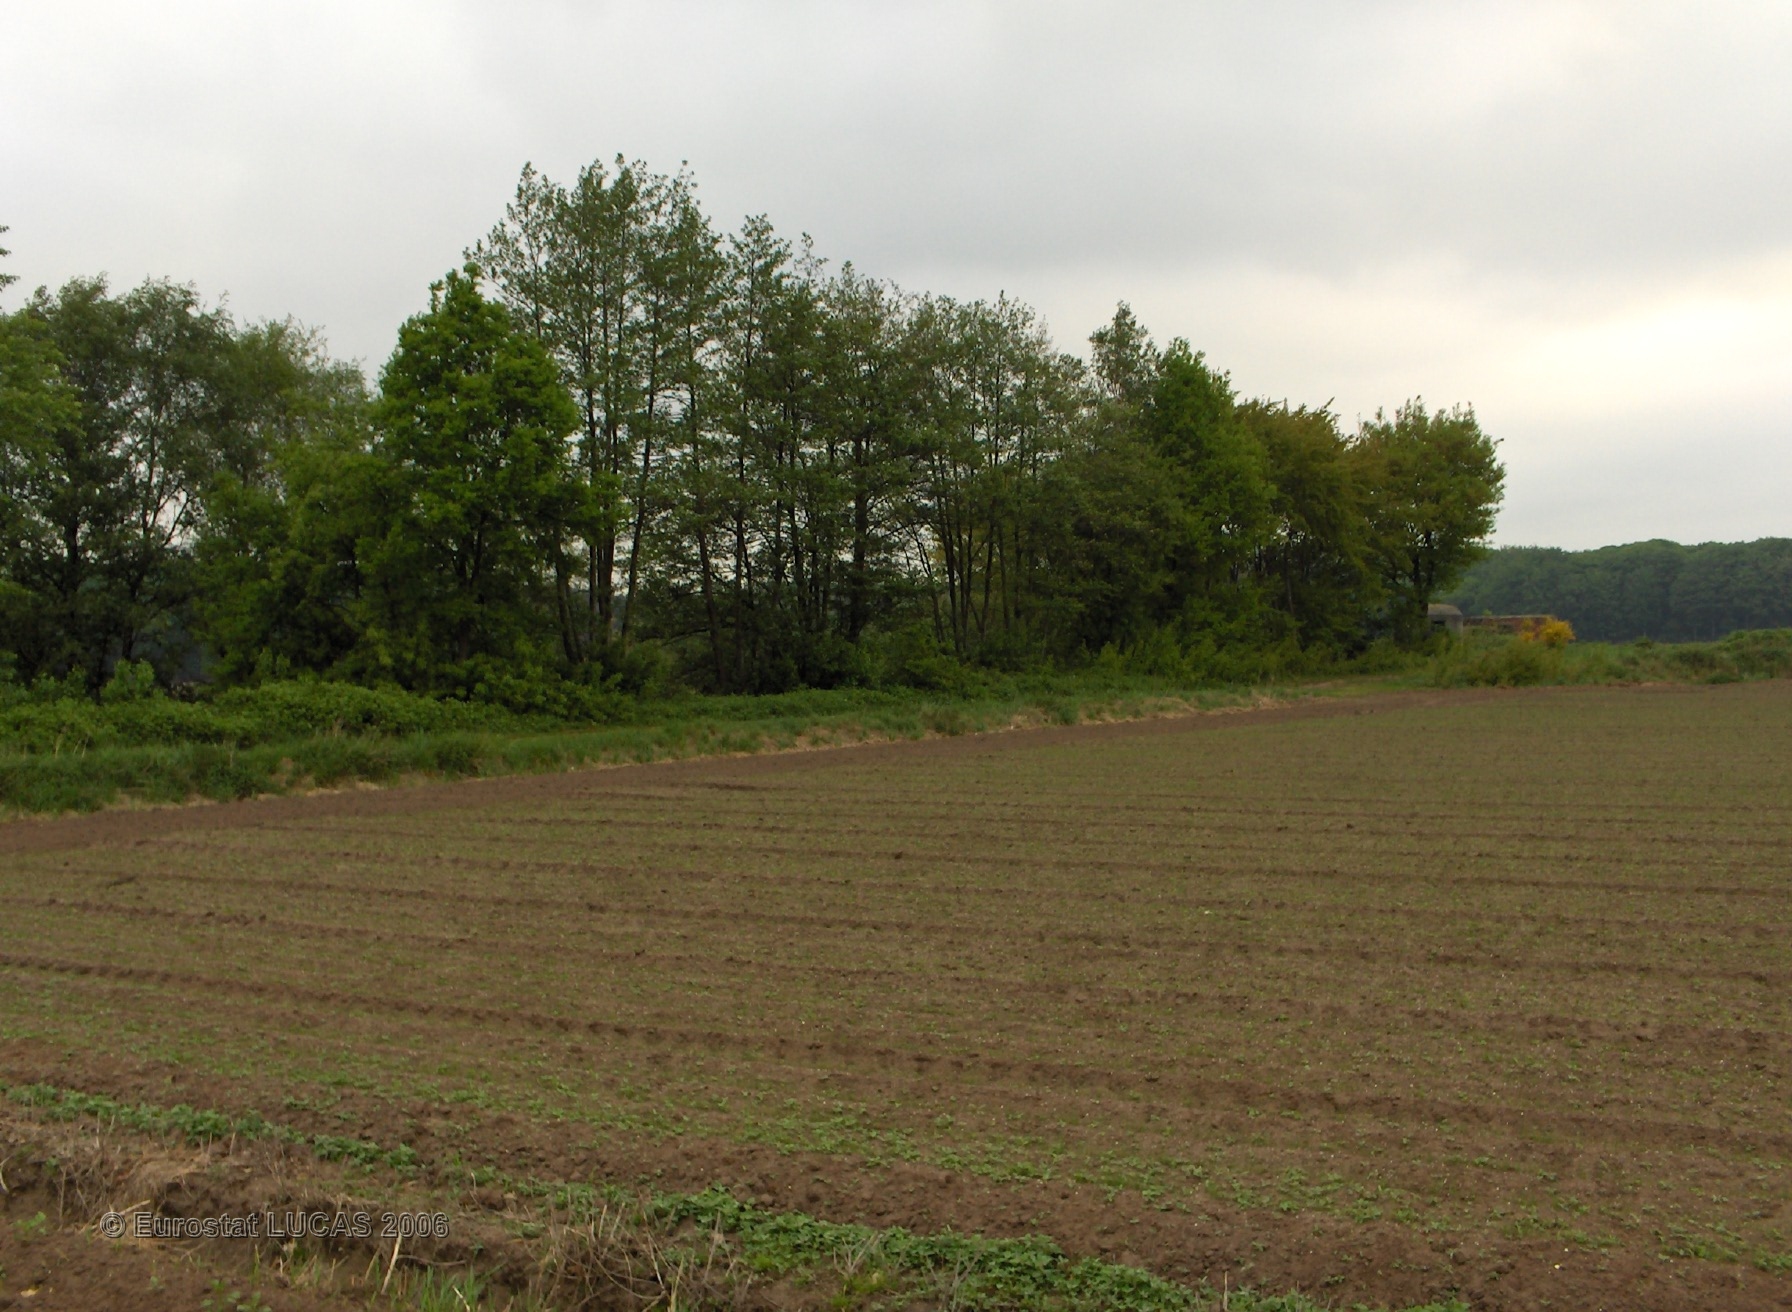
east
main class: Bare land
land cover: Bare land
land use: Agriculture (excluding fallow land and kitchen gardens)
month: May
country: BE
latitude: 51.3435
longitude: 4.3821
